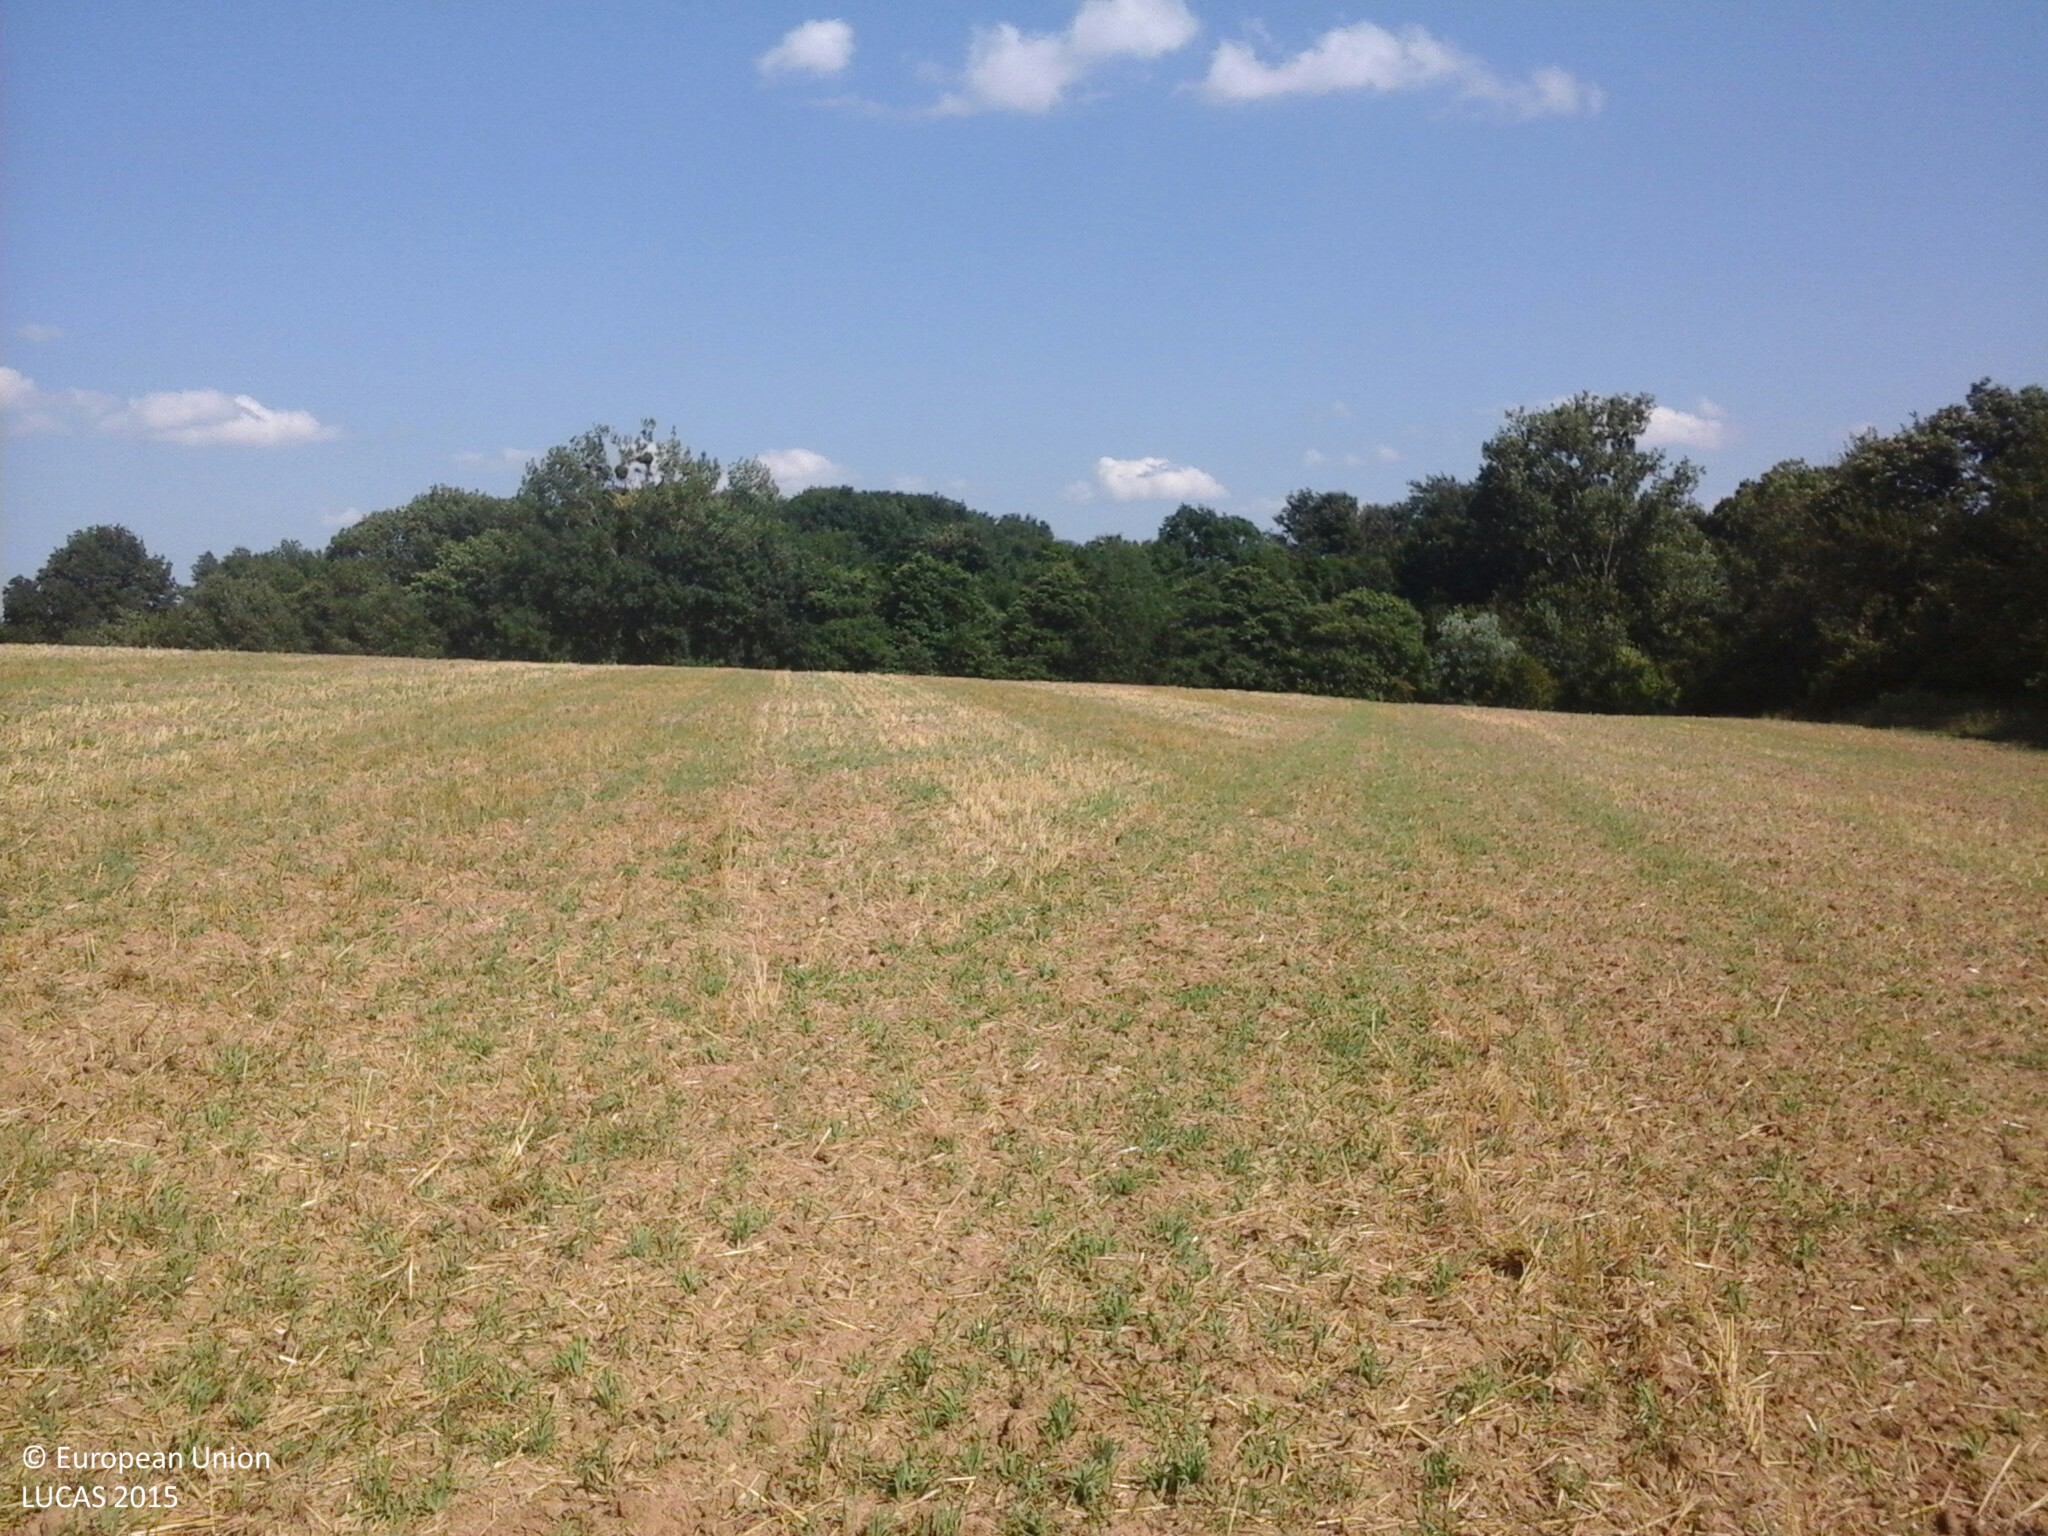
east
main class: Cropland
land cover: Barley
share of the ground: > 75 %
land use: Agriculture (excluding fallow land and kitchen gardens)
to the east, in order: Barley; Tracks; Broadleaved woodland; Tracks; Broadleaved woodland
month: July
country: HU
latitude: 47.2688
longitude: 17.9268
